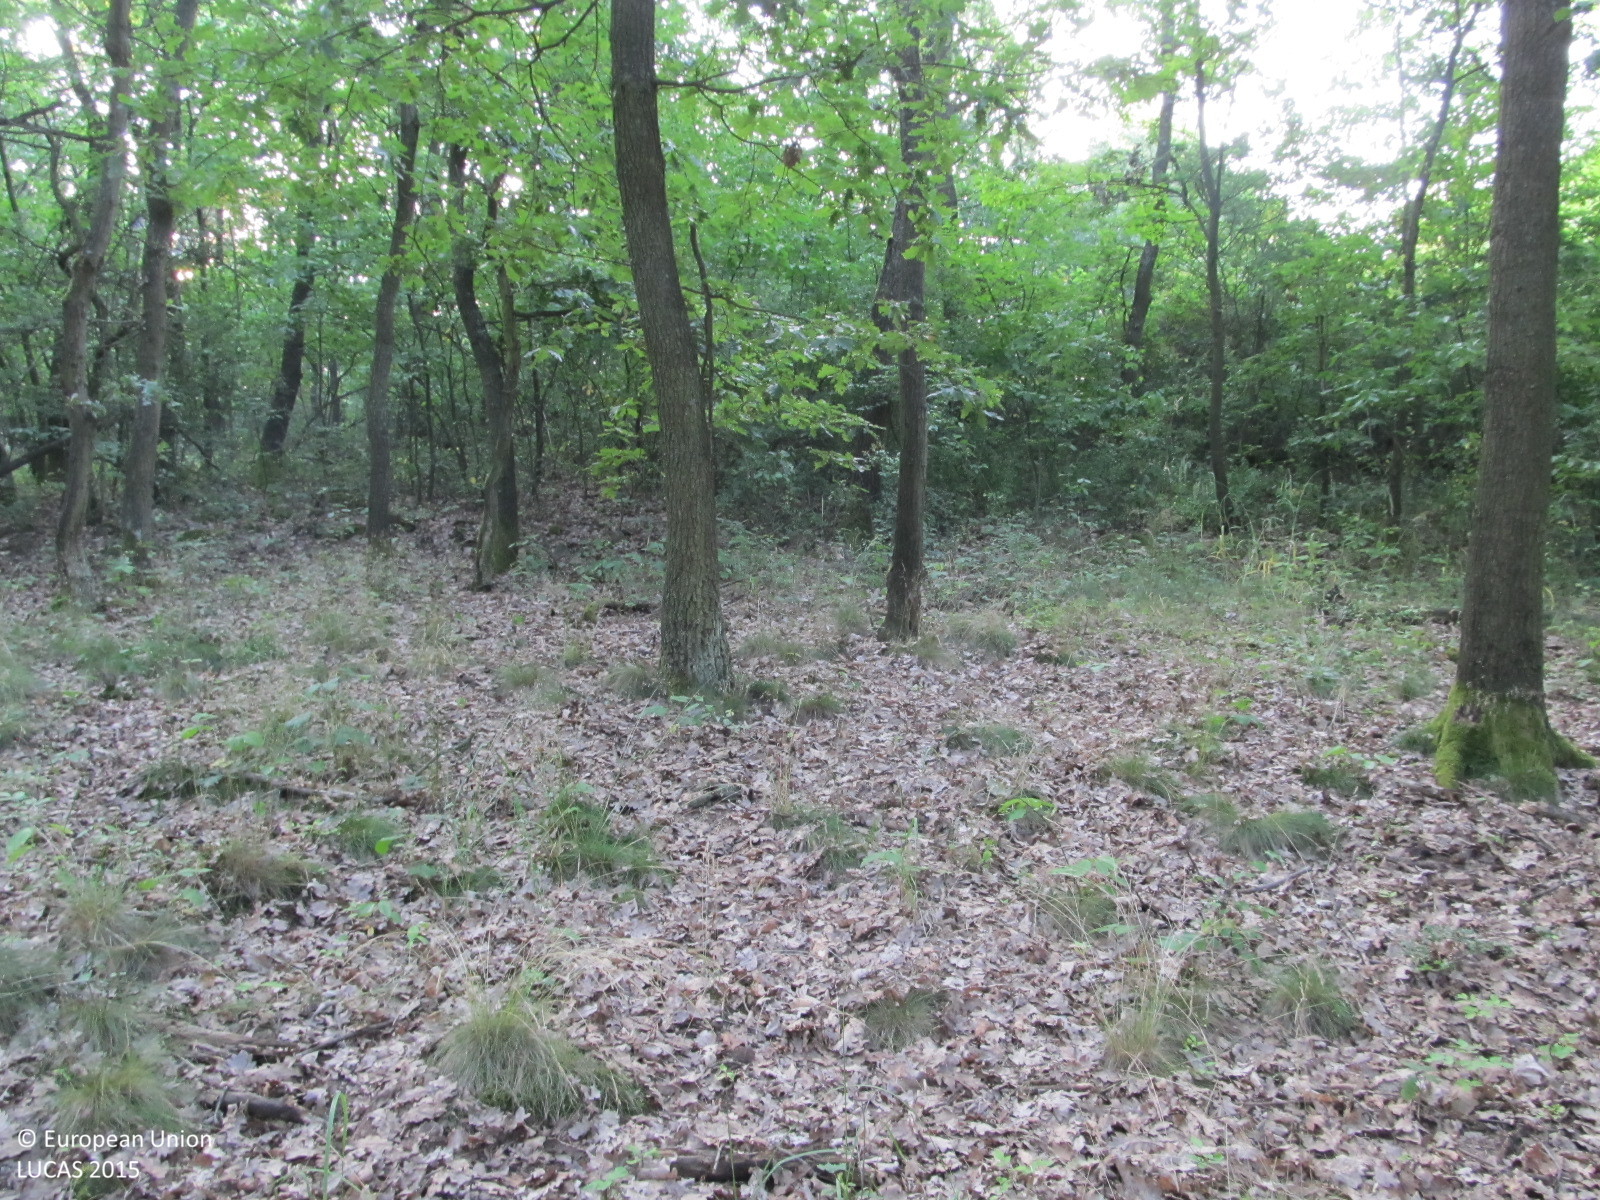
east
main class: Woodland
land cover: Broadleaved woodland
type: mesophytic deciduous forest
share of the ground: > 75 %
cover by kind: broadleaved forest trees 75 %, shrubs 10 %, herbaceous plants 10 %, unconsolidated bare surface 5 %
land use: Forestry
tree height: > 5 m
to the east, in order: Broadleaved woodland; Tracks; Broadleaved woodland; Grass margins; Rye
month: July
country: AT
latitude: 48.7184
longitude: 15.8351
